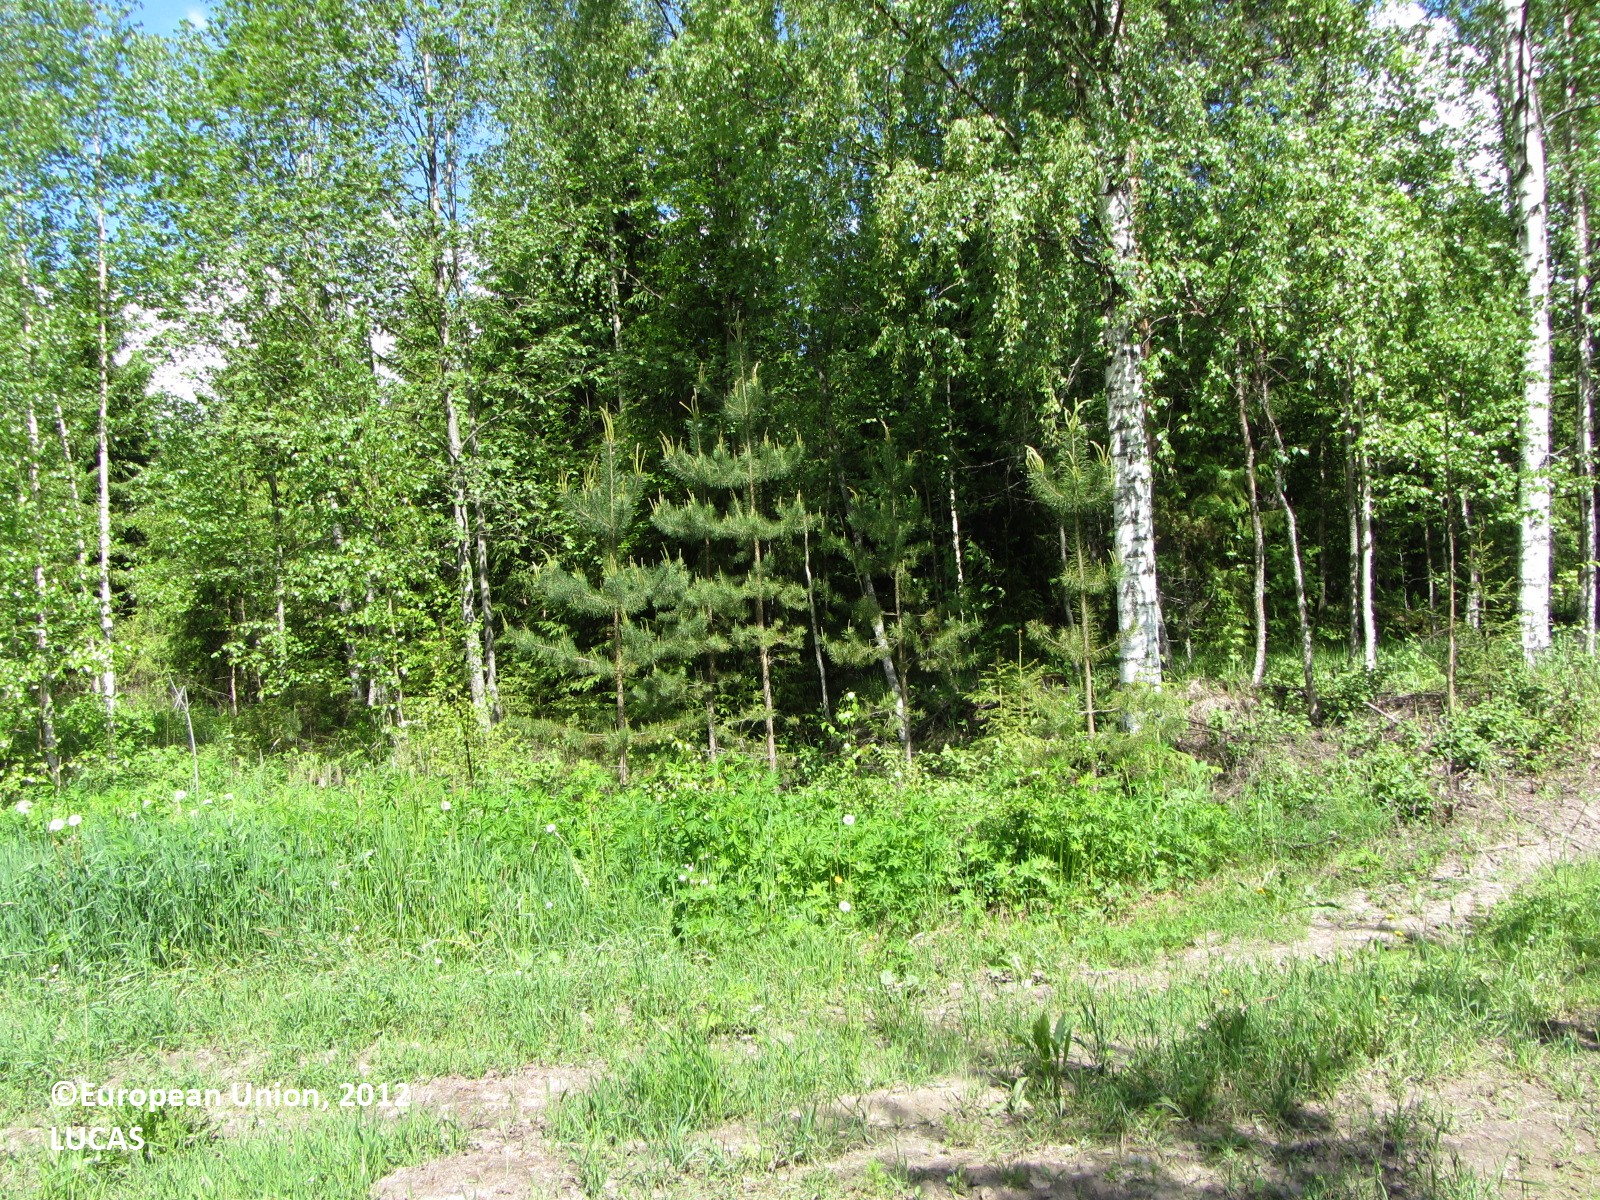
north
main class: Grassland
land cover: Spontaneously vegetated surfaces
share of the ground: 50 - 75 %
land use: Semi-natural and natural areas not in use
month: June
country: FI
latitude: 61.9953
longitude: 24.7030
